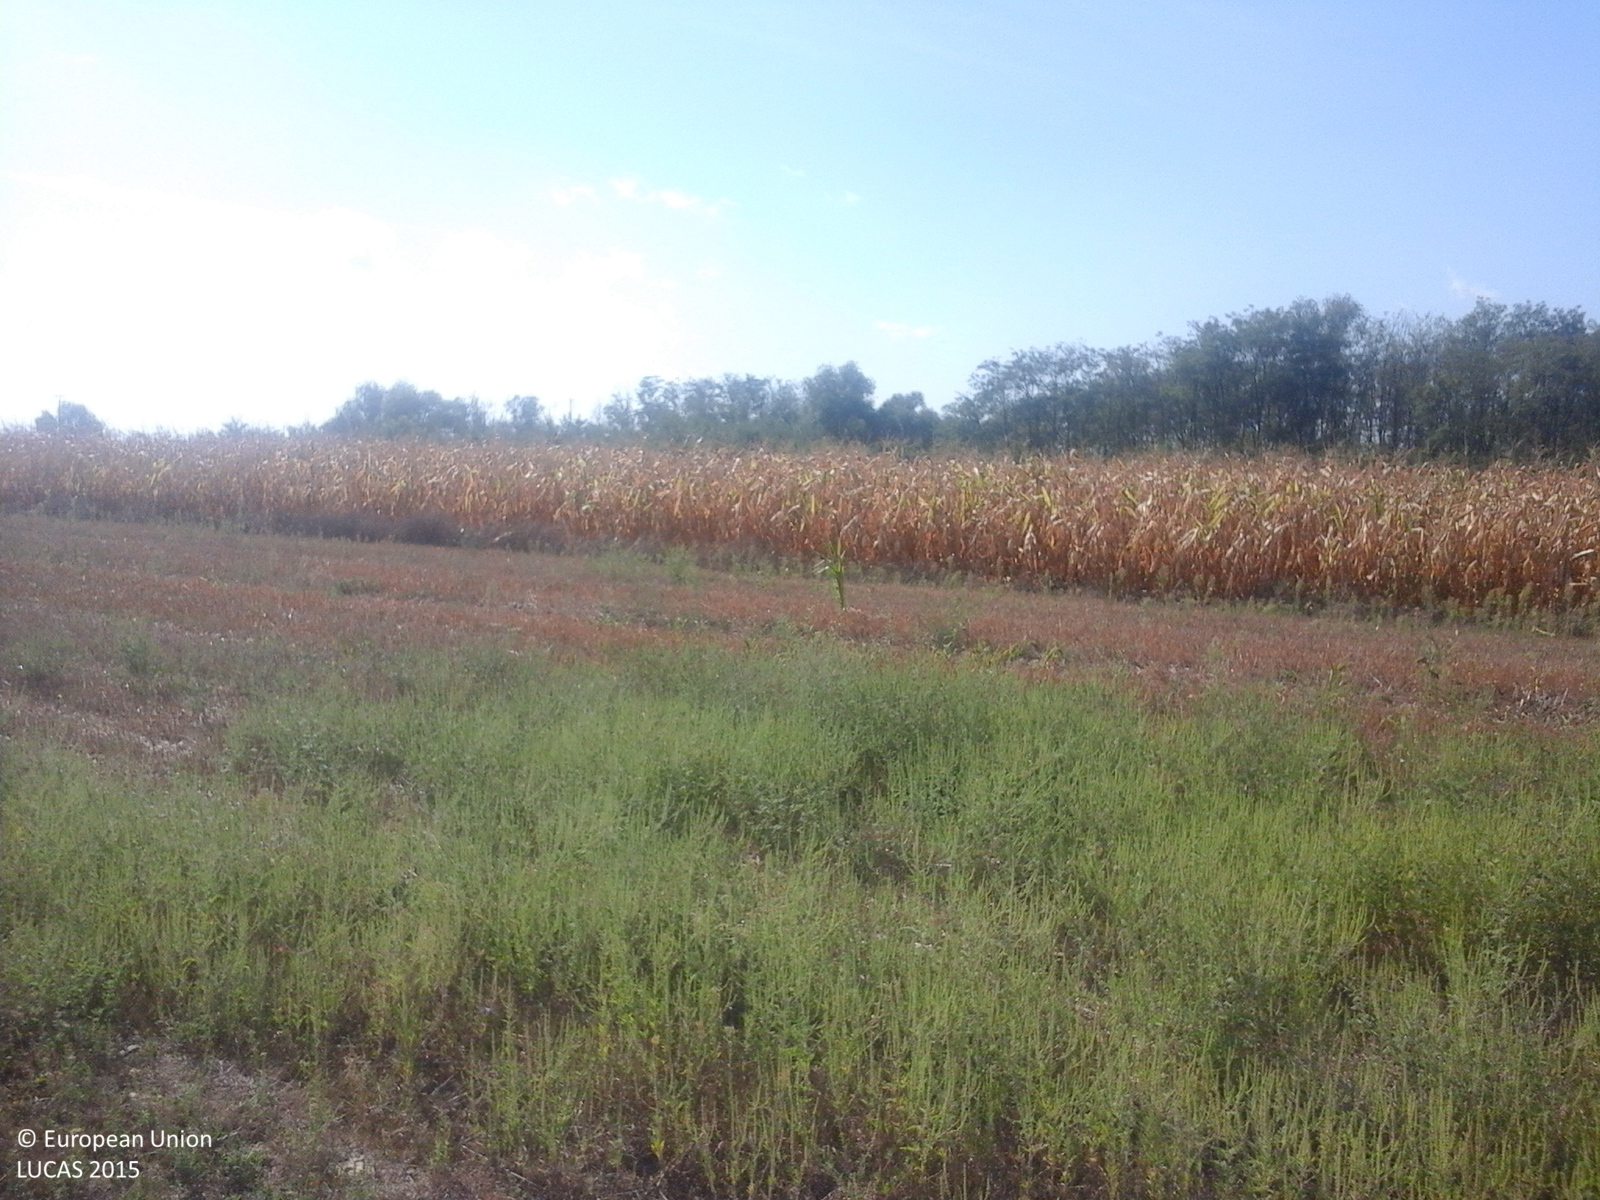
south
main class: Cropland
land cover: Lucerne
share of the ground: > 75 %
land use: Agriculture (excluding fallow land and kitchen gardens)
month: September
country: RO
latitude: 47.9112
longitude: 22.9511
